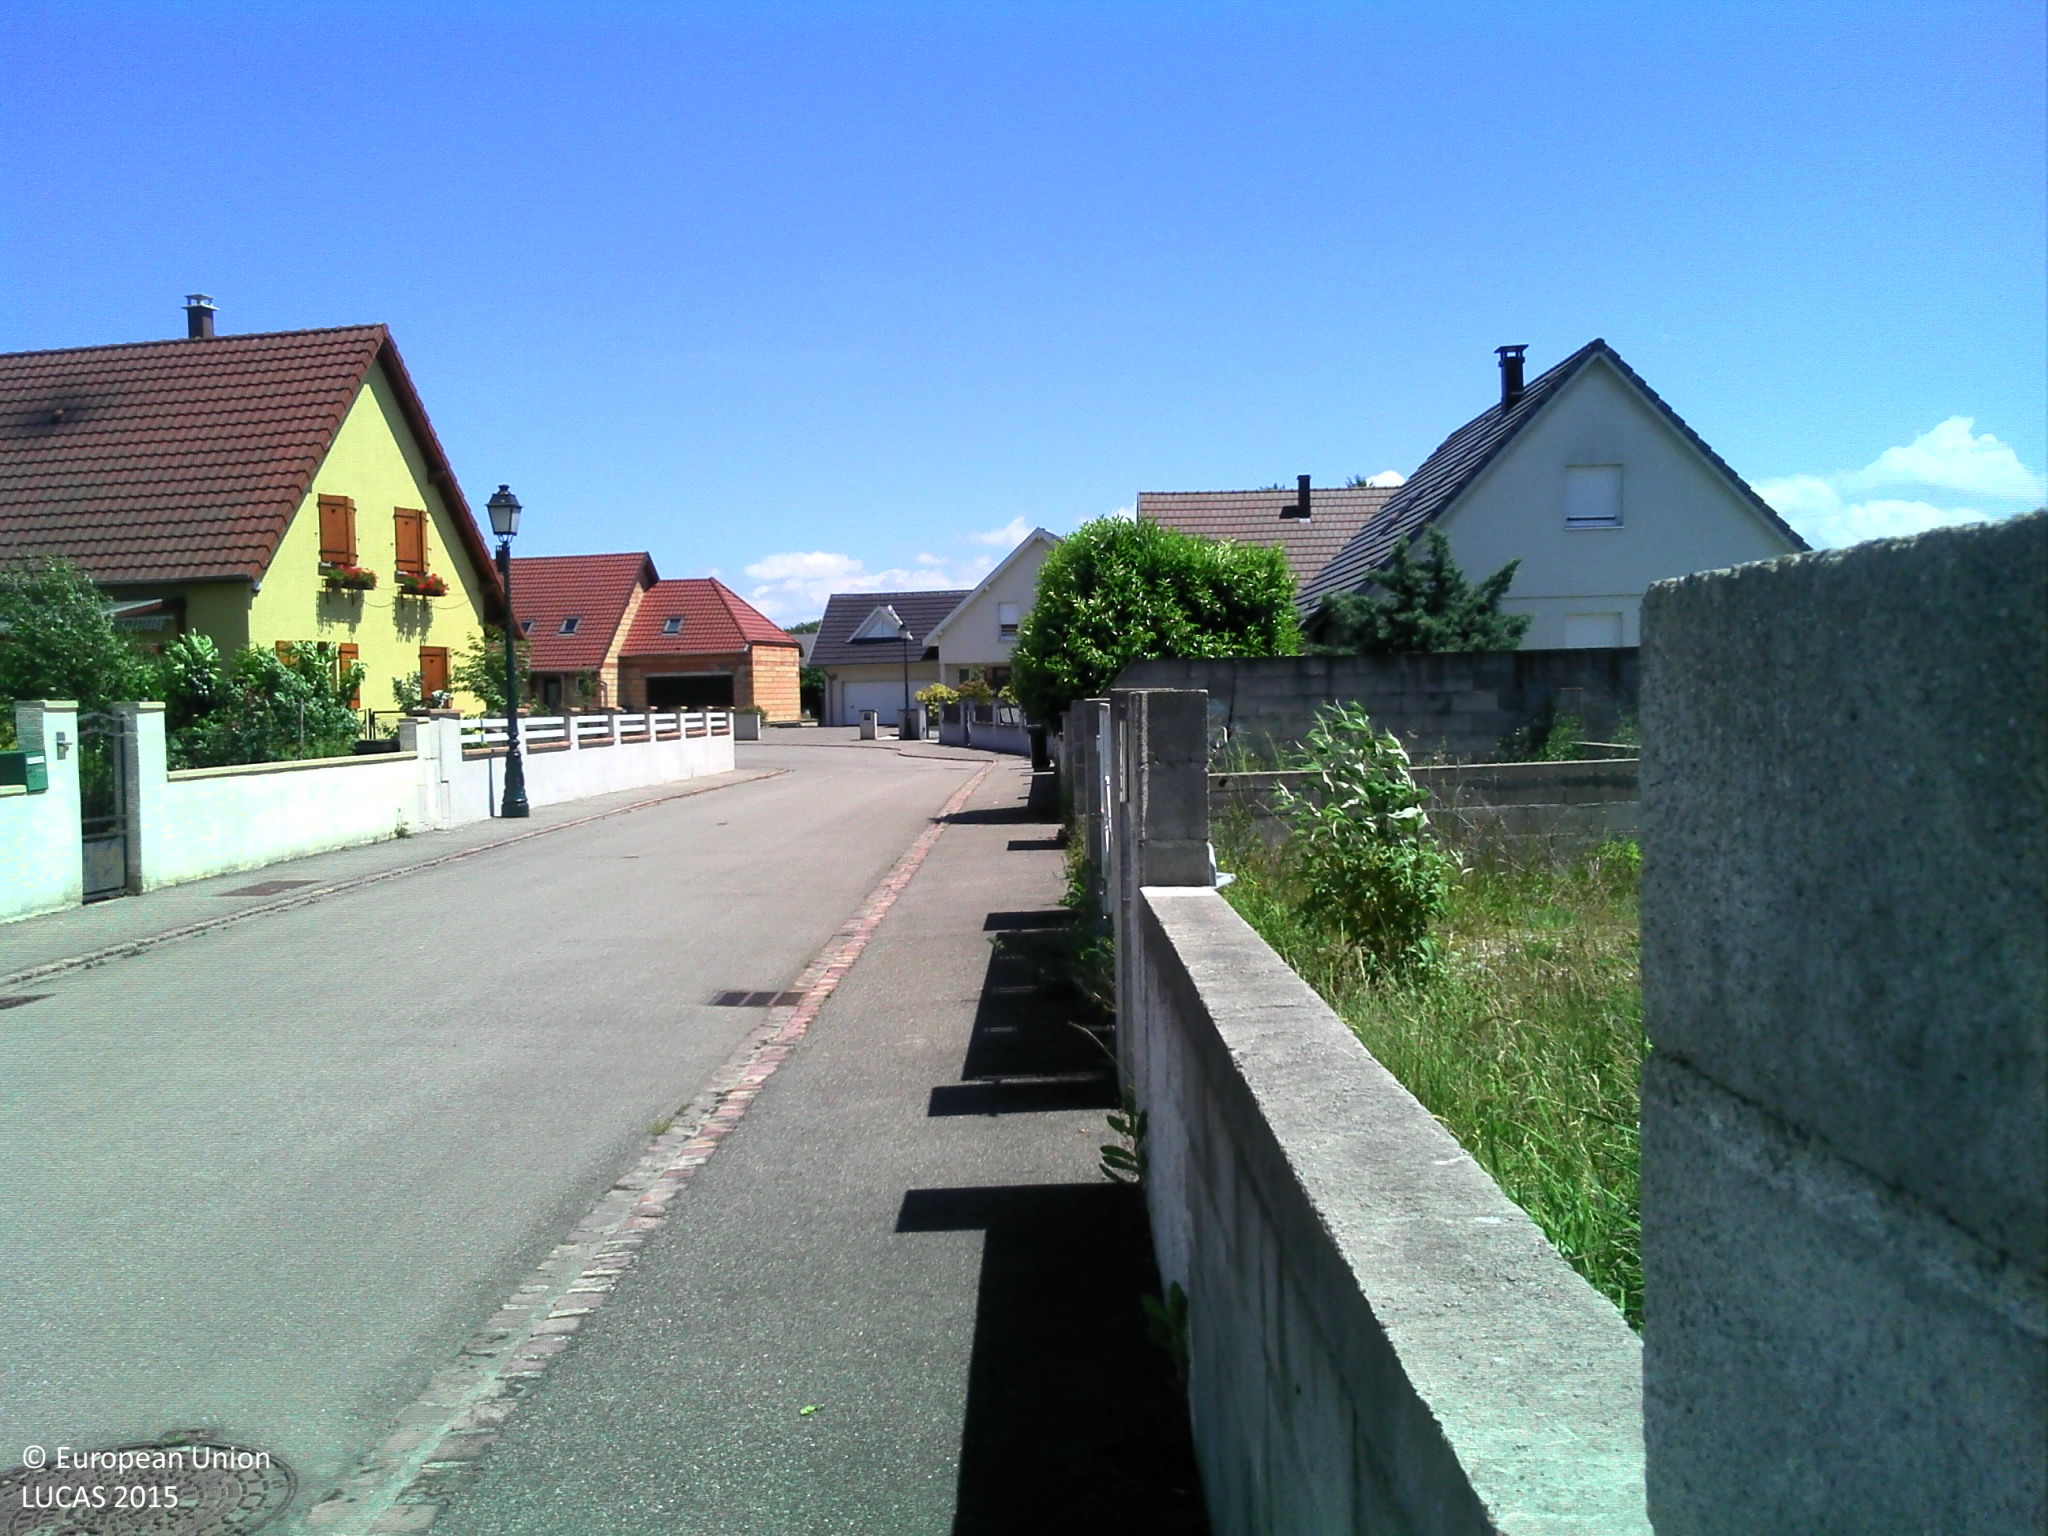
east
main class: Grassland
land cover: Grassland with sparse tree/shrub cover
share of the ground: > 75 %
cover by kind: herbaceous plants 95 %, broadleaved forest trees 5 %
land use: Residential
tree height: < 5 m
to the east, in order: Grassland with sparse tree/shrub cover; Artificial constructions in urban areas; Maize; Artificial constructions in urban areas
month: June
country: FR
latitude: 47.9586
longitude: 7.3898
